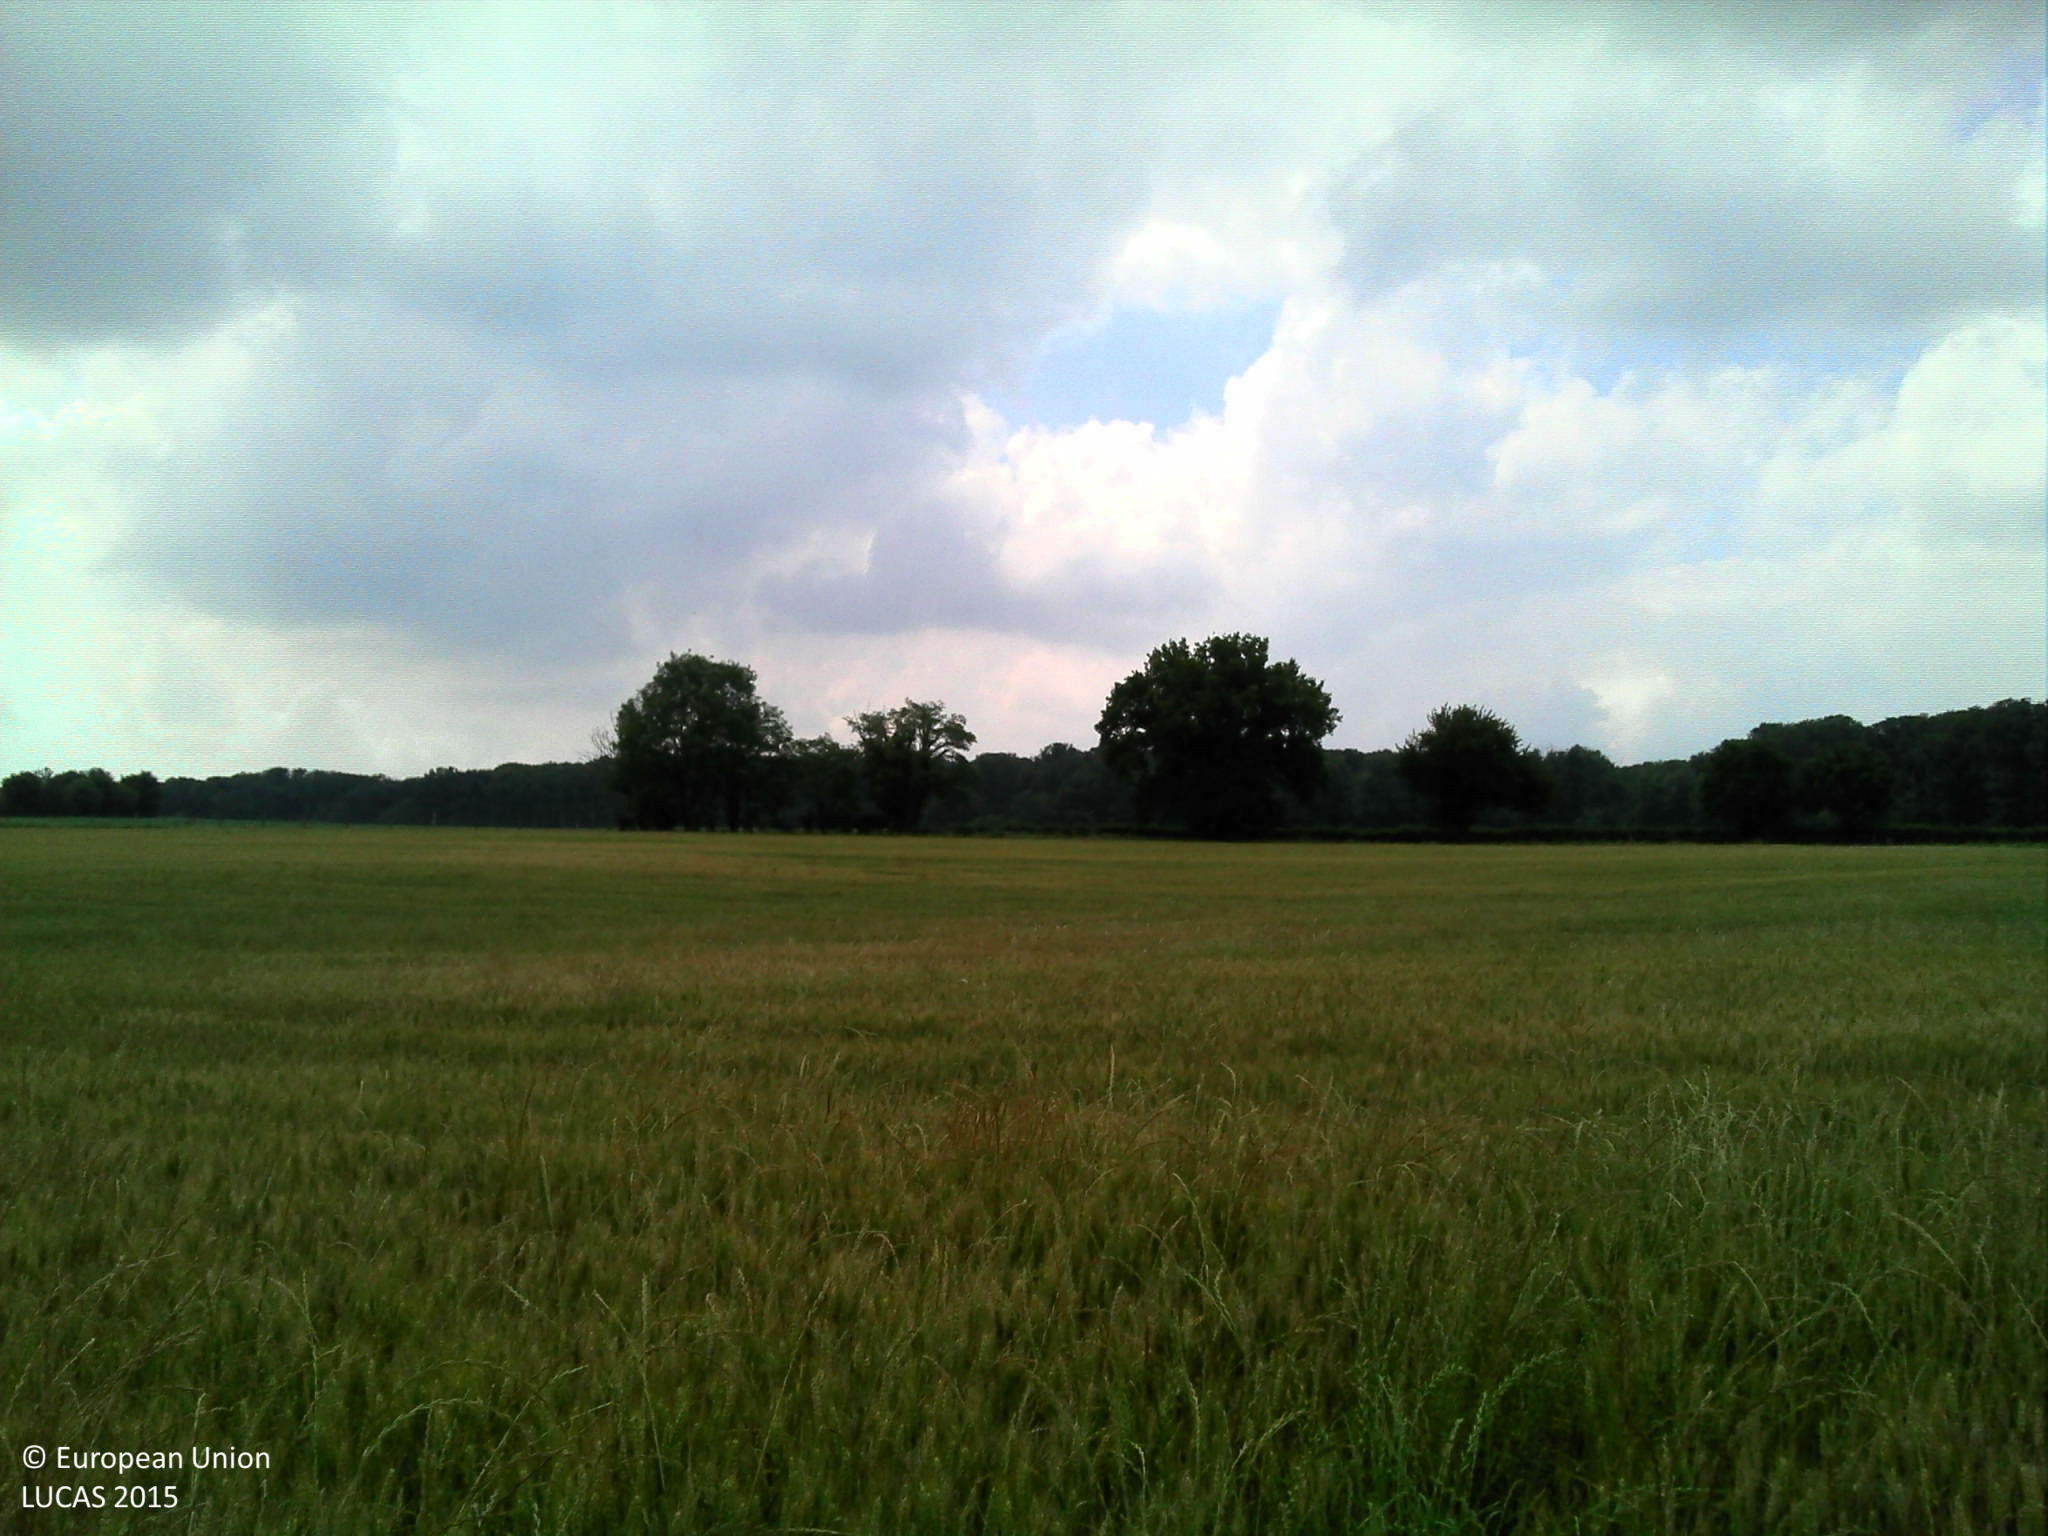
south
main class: Cropland
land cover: Common wheat
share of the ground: > 75 %
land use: Agriculture (excluding fallow land and kitchen gardens)
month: June
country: FR
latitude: 46.6077
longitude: 2.6973
